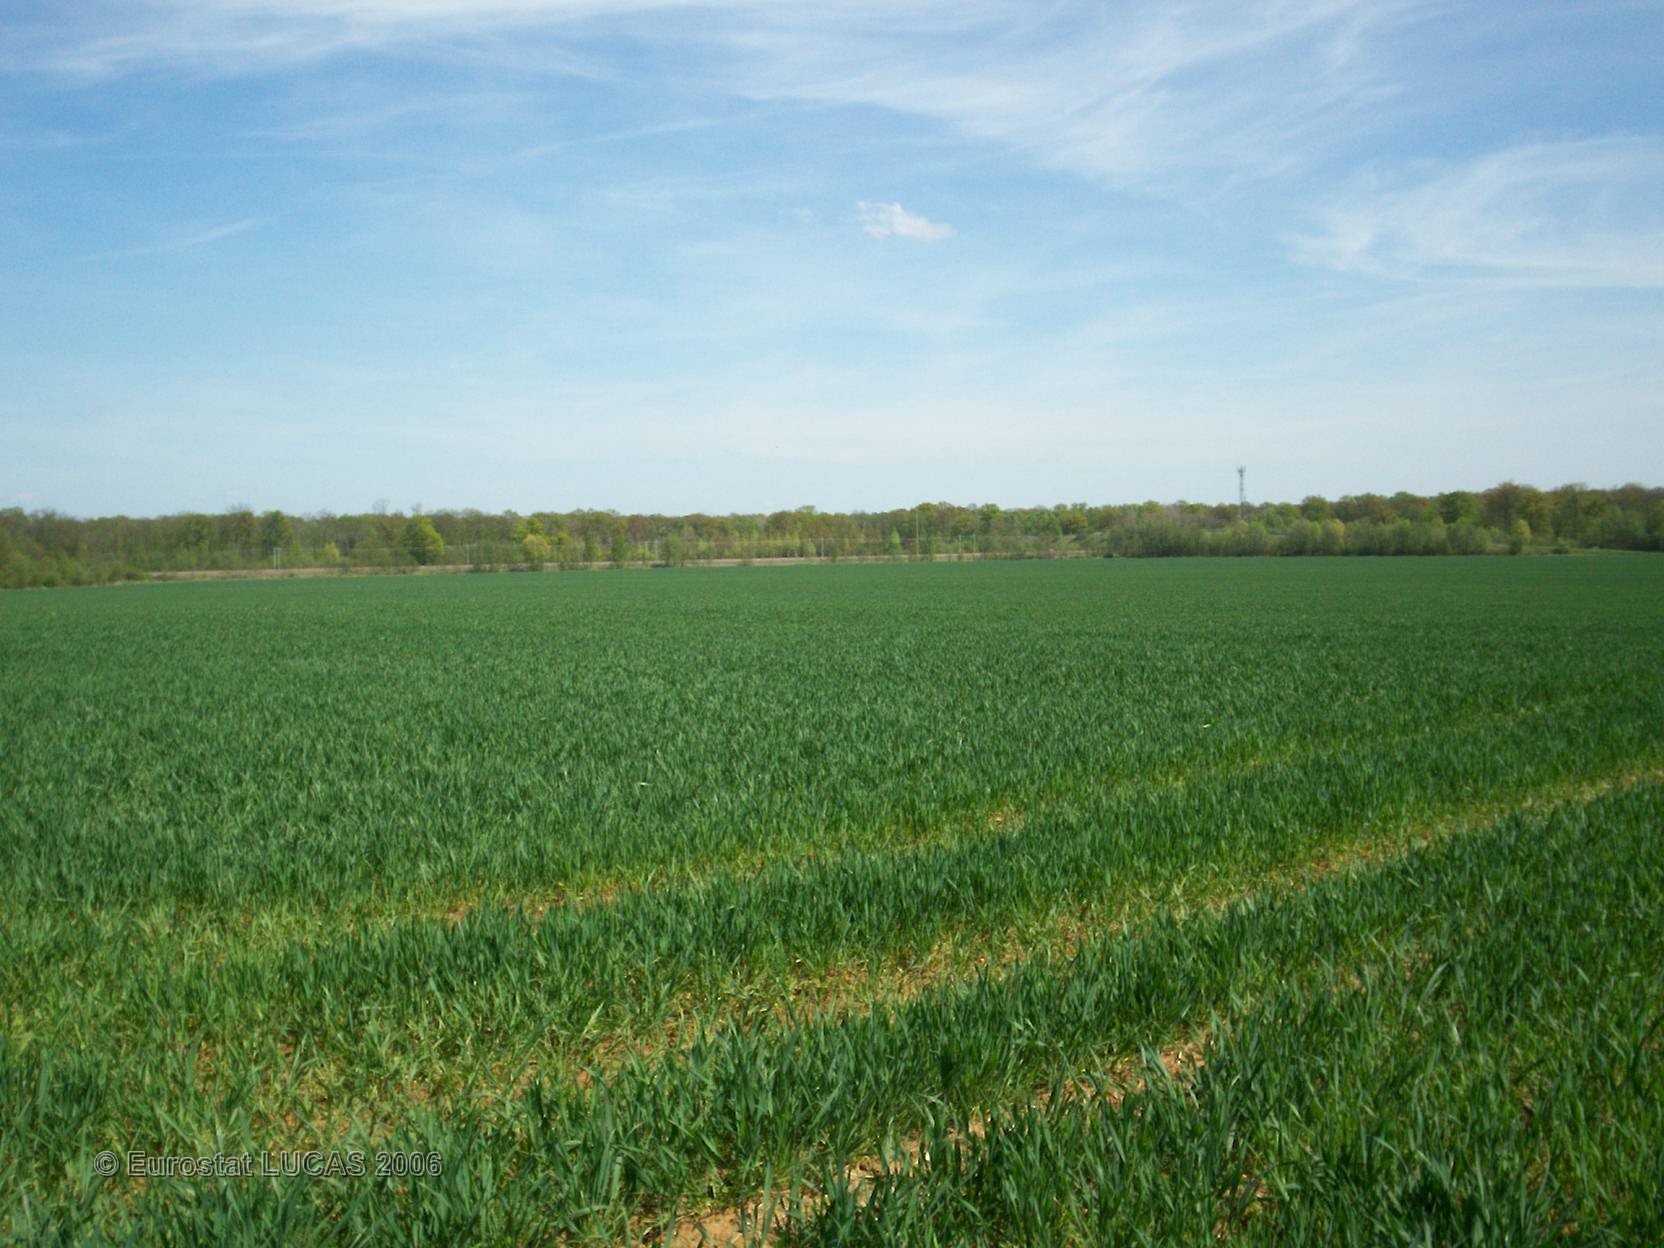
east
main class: Cropland
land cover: Common wheat
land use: Agriculture (excluding fallow land and kitchen gardens)
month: May
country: FR
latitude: 48.8001
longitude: 2.7884
